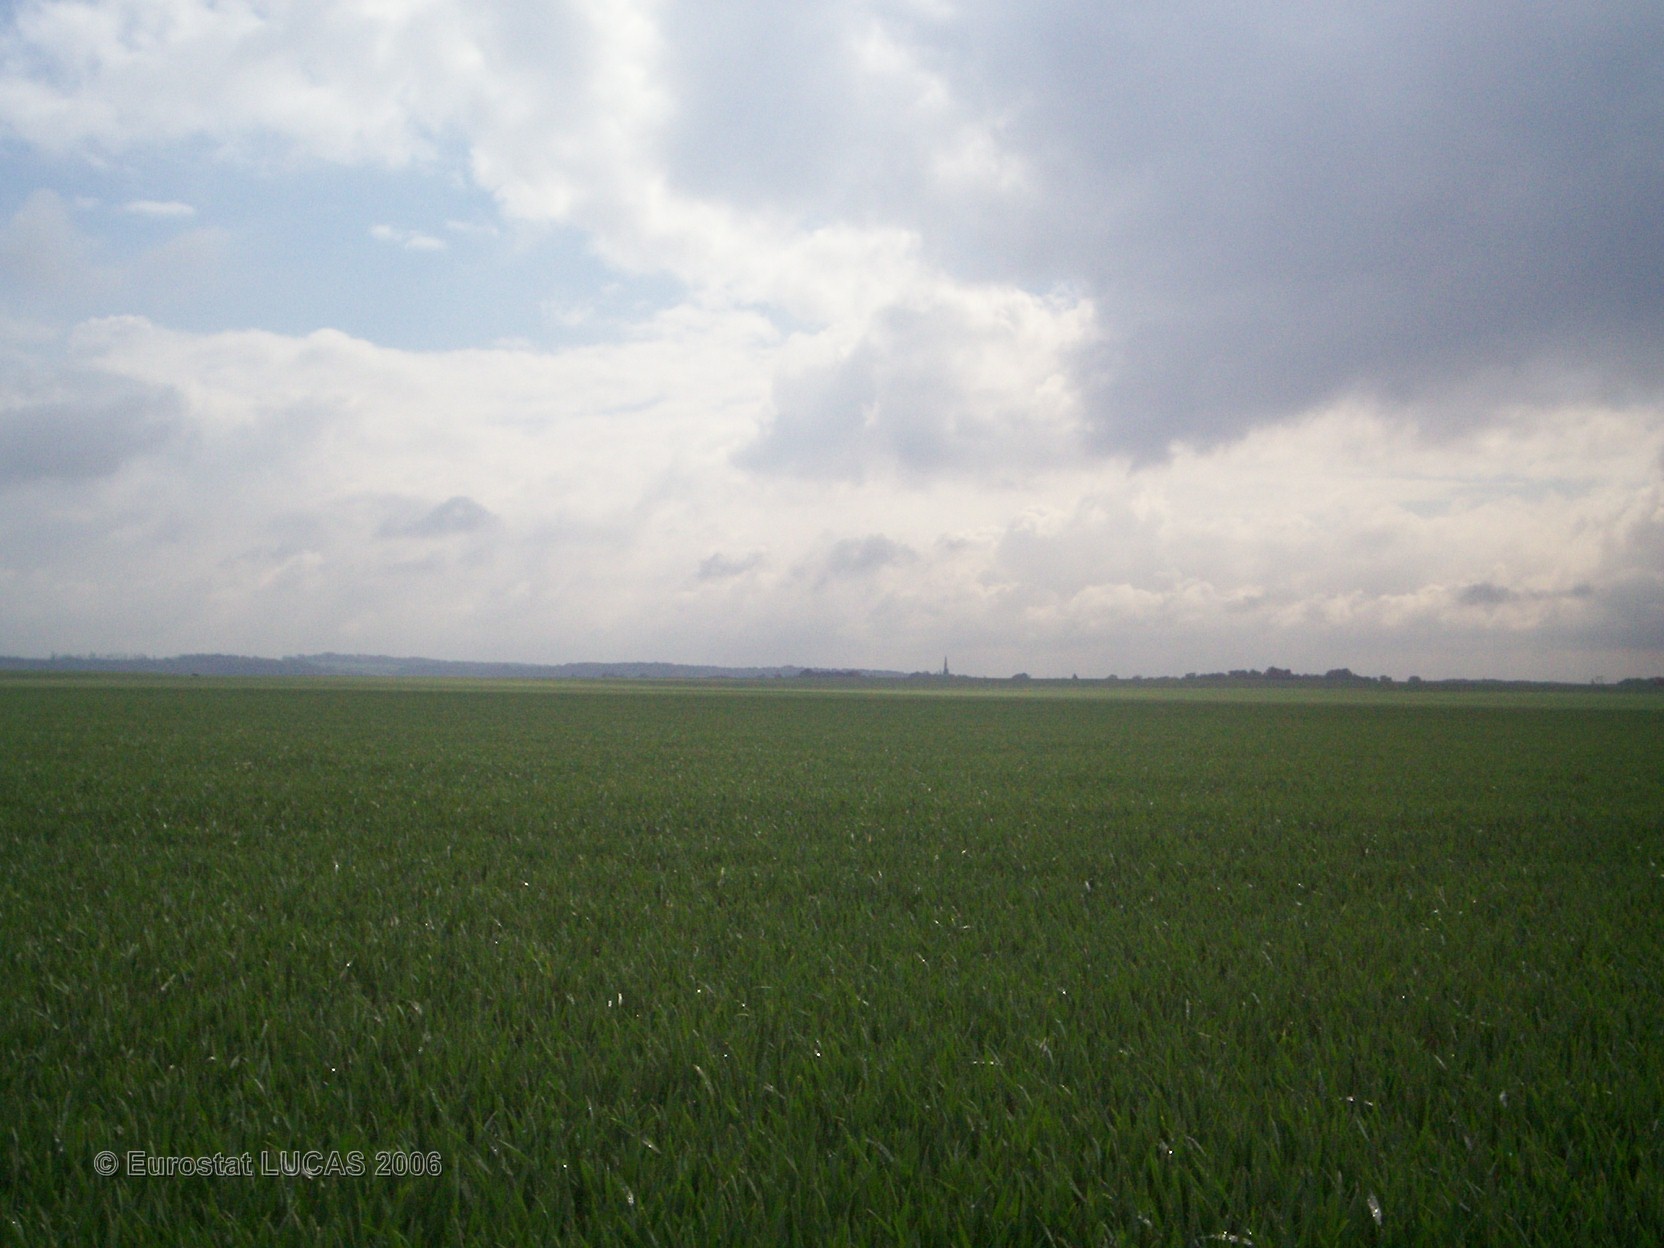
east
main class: Cropland
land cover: Common wheat
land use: Agriculture (excluding fallow land and kitchen gardens)
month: May
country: FR
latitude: 49.1740
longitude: 2.7058
